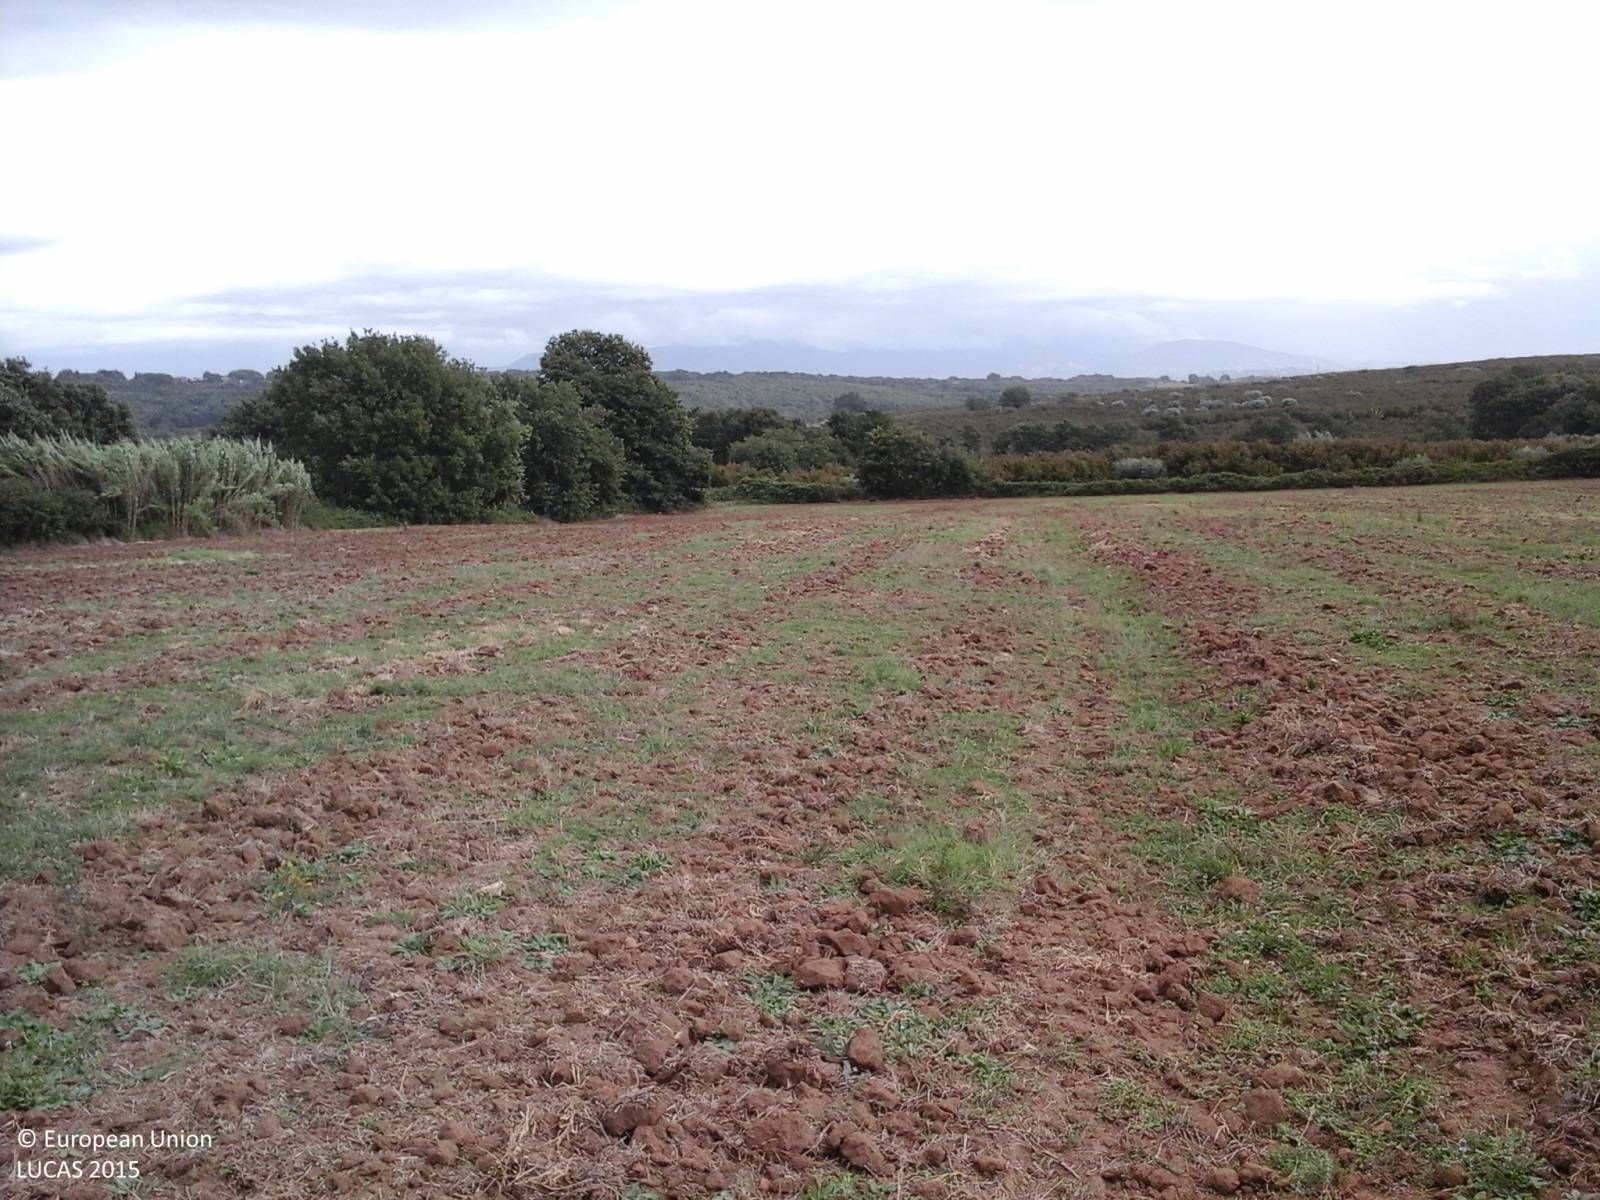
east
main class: Grassland
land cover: Spontaneously vegetated surfaces
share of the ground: 50 - 75 %
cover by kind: herbaceous plants 65 %, unconsolidated bare surface 35 %
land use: Agriculture (excluding fallow land and kitchen gardens)
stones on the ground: < 10 %
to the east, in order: Spontaneously vegetated surfaces; Shruby margins; Fences; Ditches and canals; Grass margins; Nuts trees; Broadleaved woodland; Ditches and canals; Broadleaved woodland
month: September
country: IT
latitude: 42.4277
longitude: 12.3622
